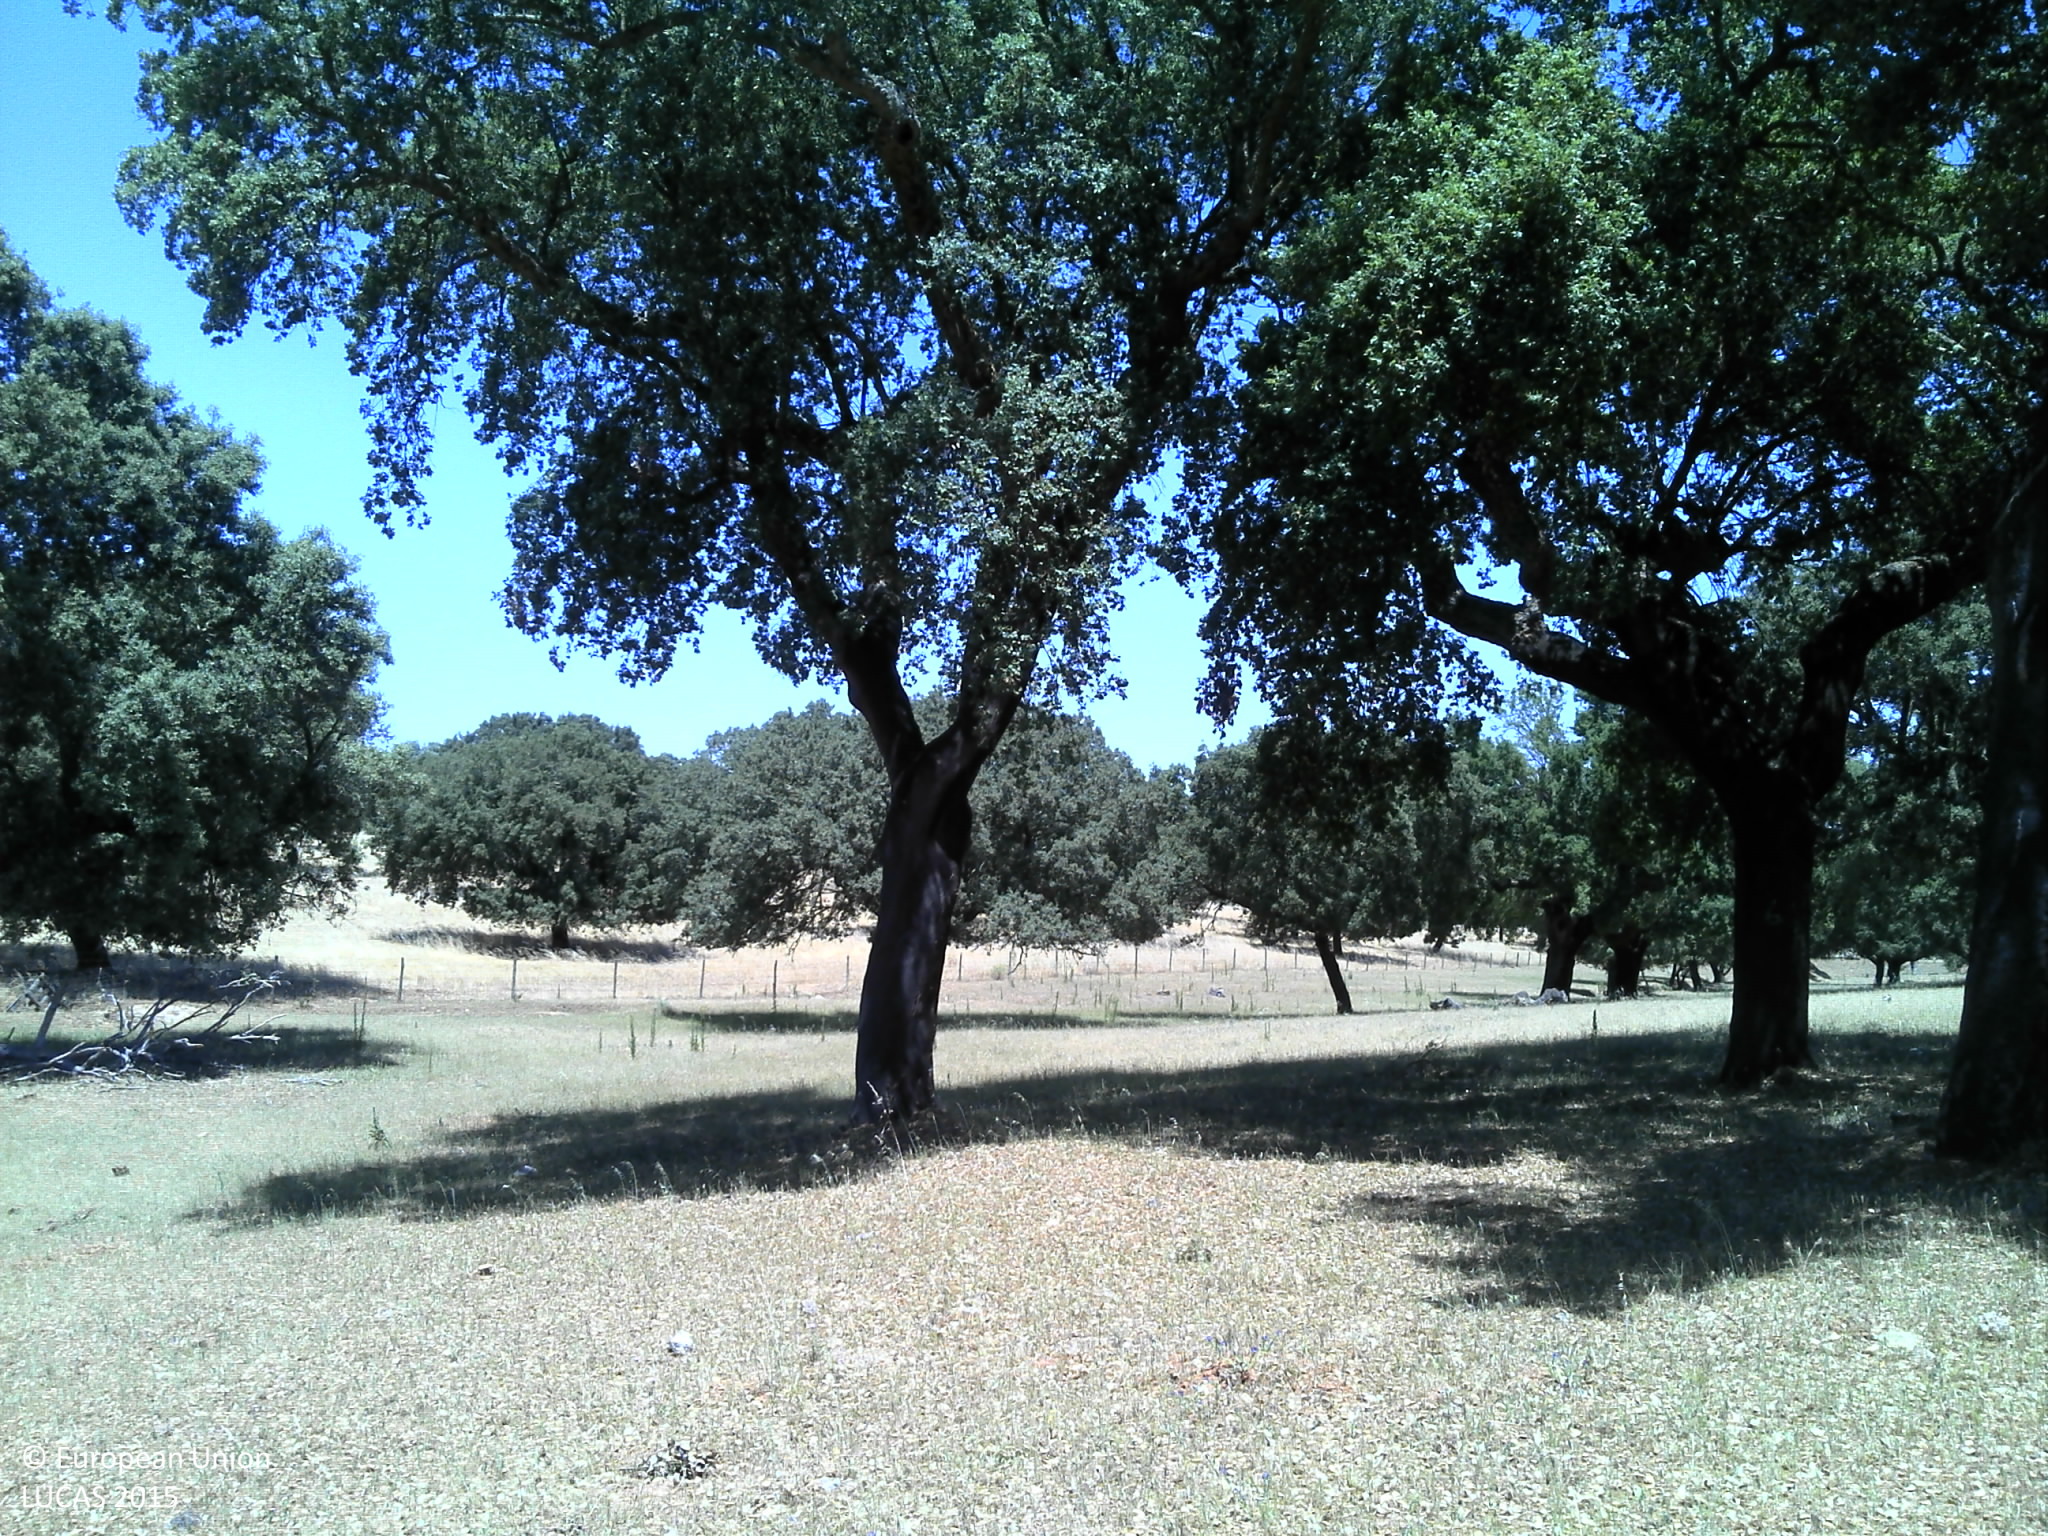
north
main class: Woodland
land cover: Broadleaved woodland
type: broadleaved evergreen forest
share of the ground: 25 - 50 %
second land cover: Grassland without tree/shrub cover
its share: 25 - 50 %
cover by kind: broadleaved forest trees 40 %, unconsolidated bare surface 35 %, herbaceous plants 25 %
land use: Forestry
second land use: Agriculture (excluding fallow land and kitchen gardens)
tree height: > 5 m
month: May
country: PT
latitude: 38.9550
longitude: -7.6141
